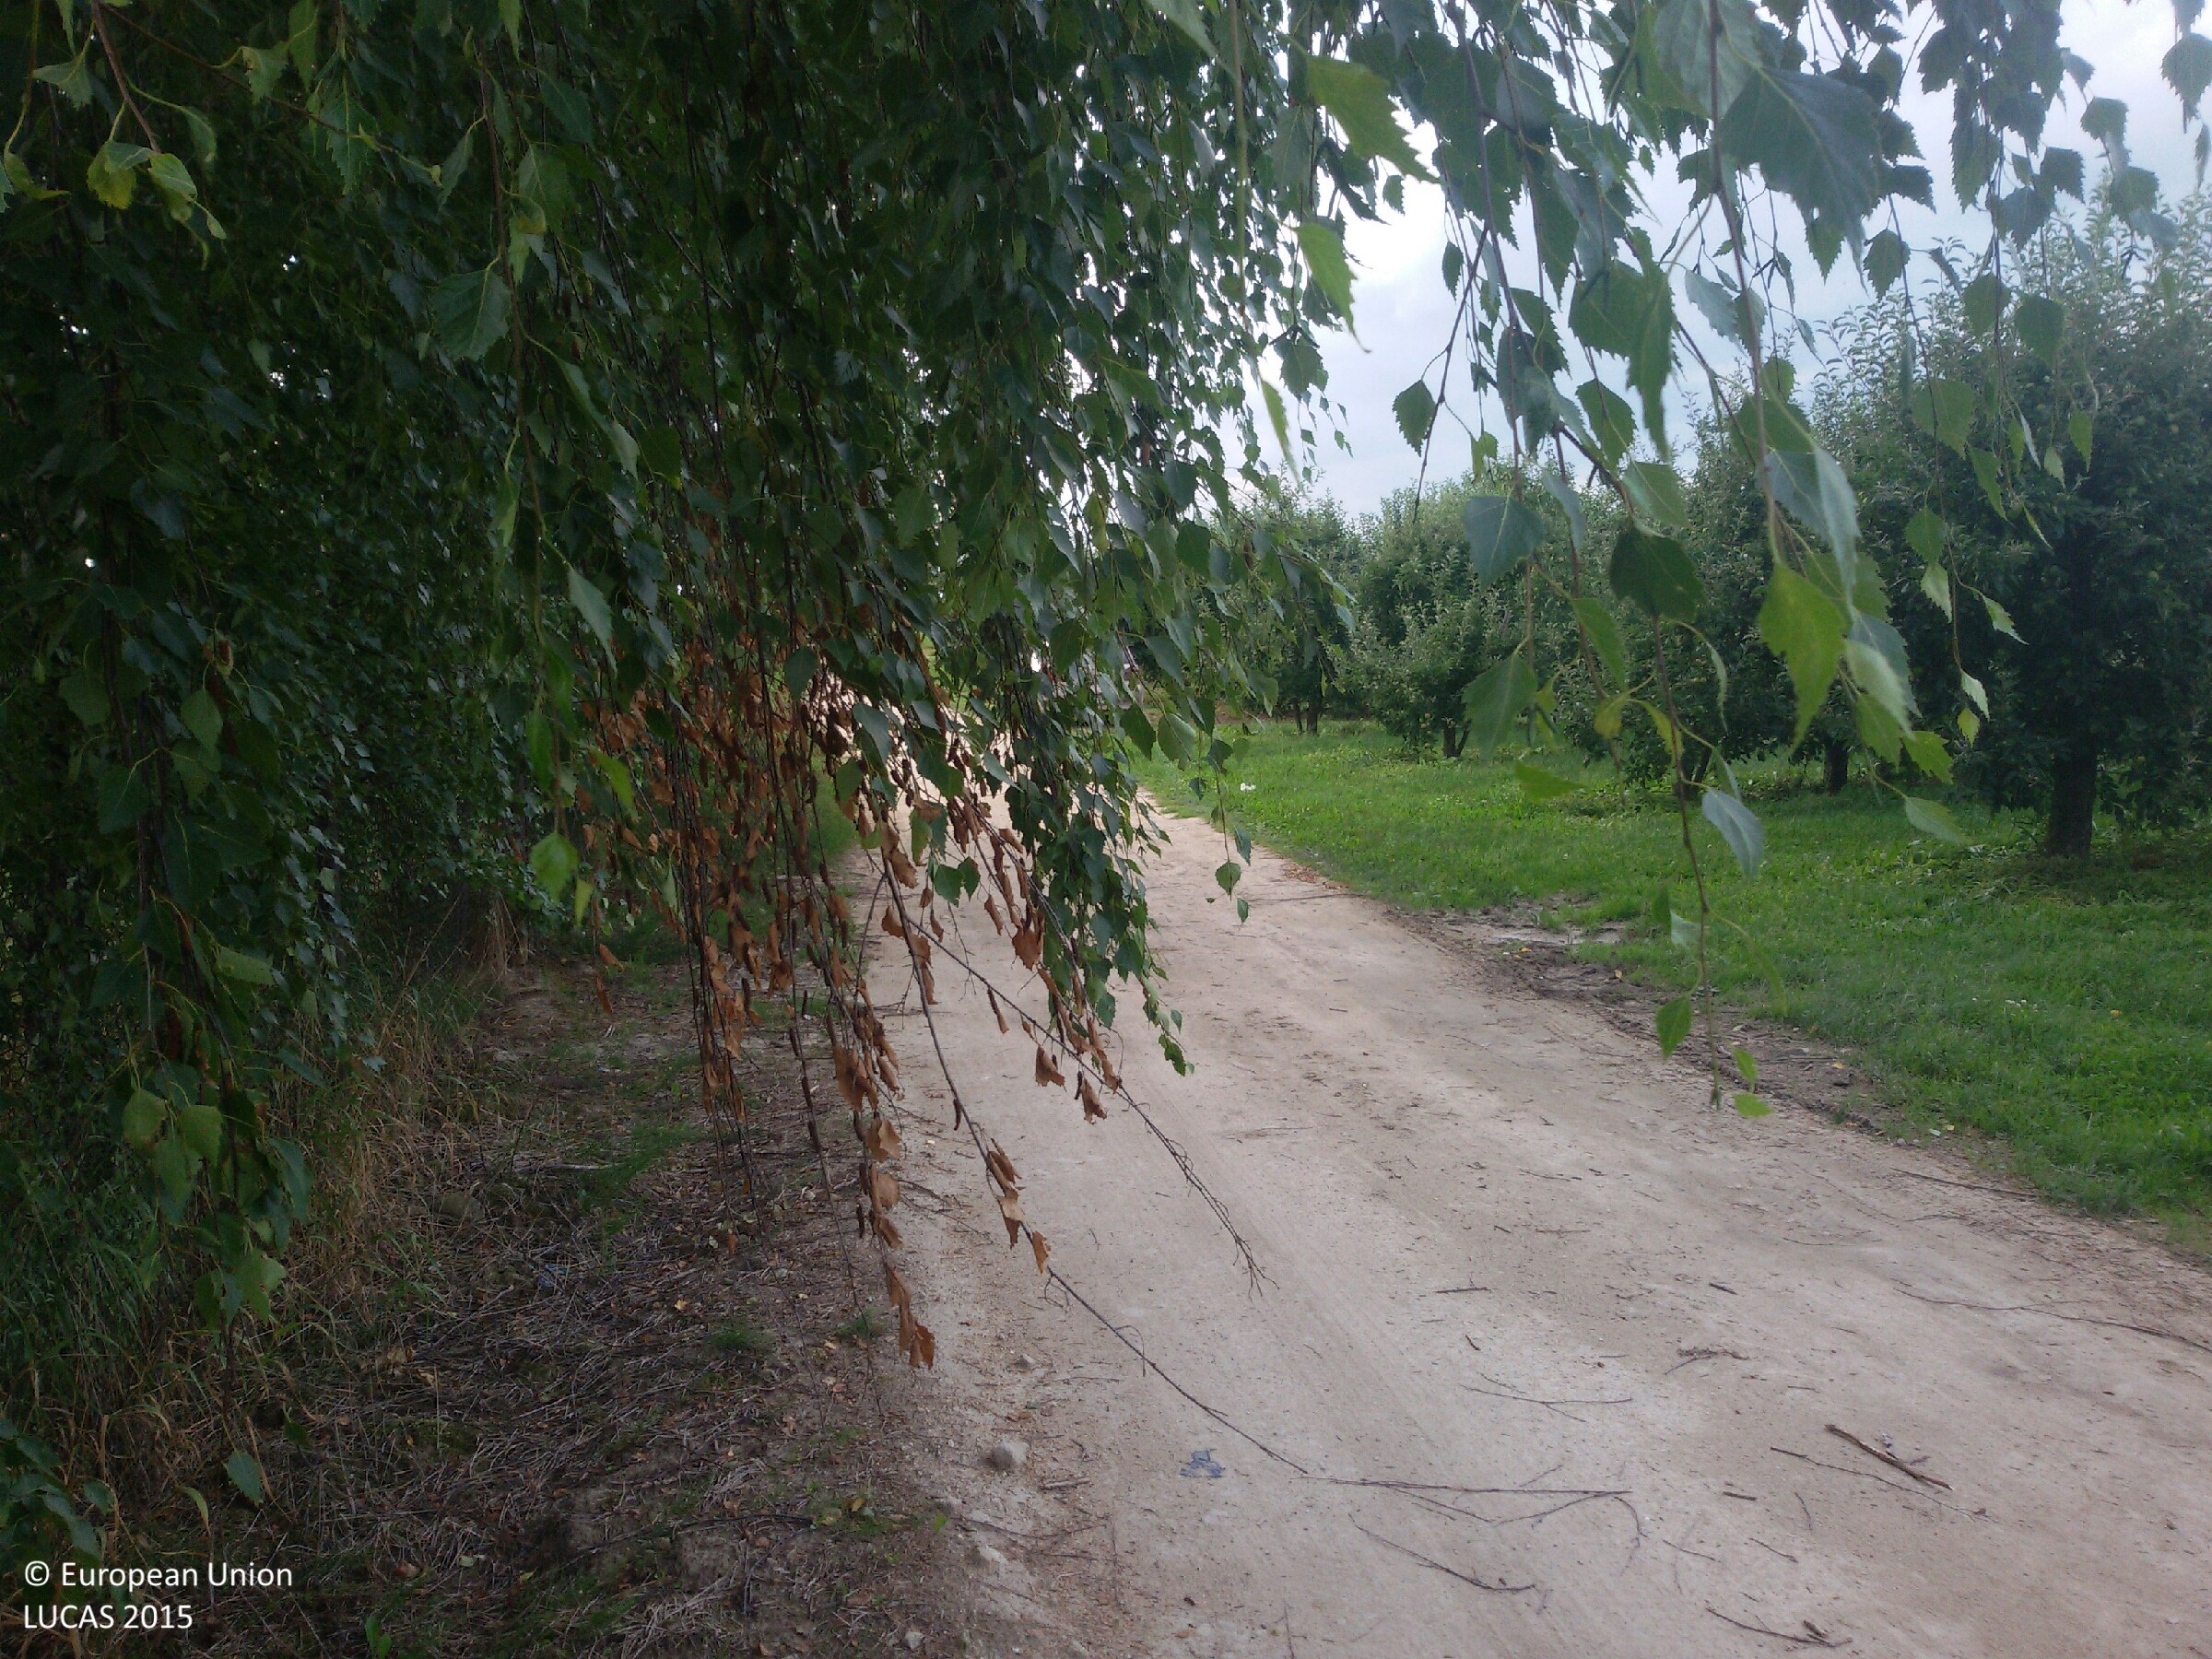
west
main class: Cropland
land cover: Other fruit trees and berries
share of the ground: > 75 %
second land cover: Grassland without tree/shrub cover
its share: > 75 %
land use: Agriculture (excluding fallow land and kitchen gardens)
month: July
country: PL
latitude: 50.7083
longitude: 21.6795
